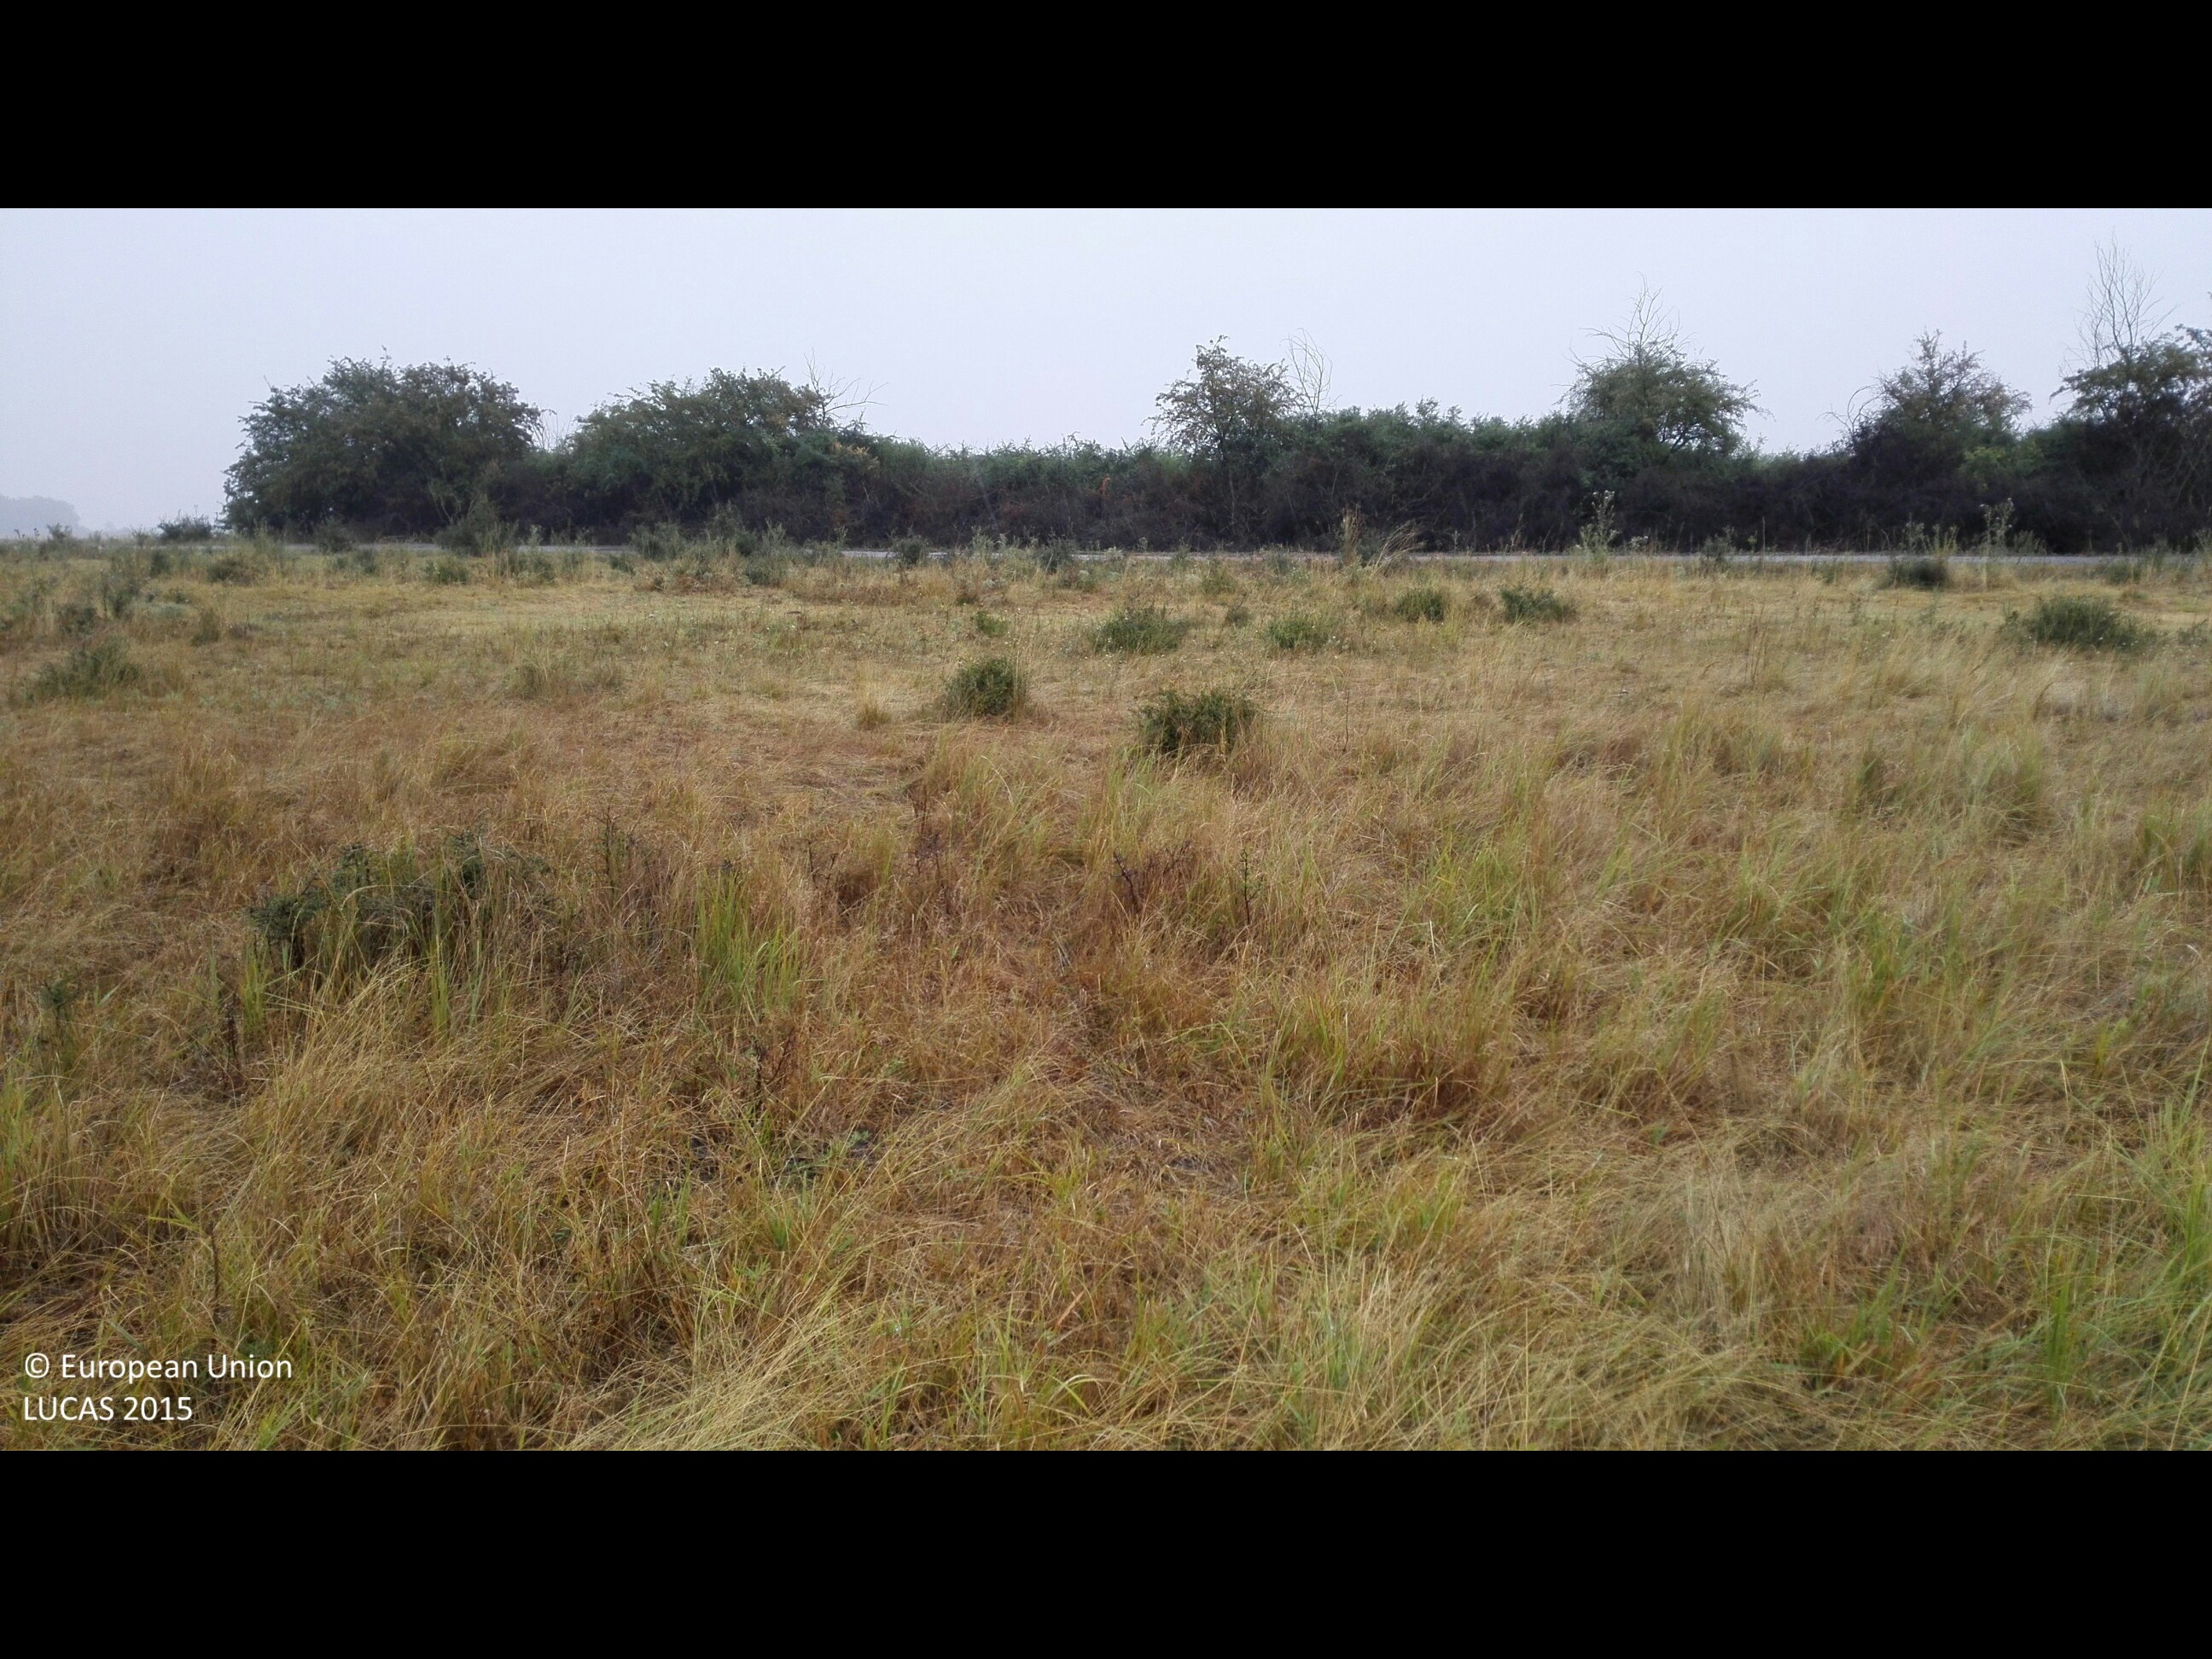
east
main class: Grassland
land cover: Grassland without tree/shrub cover
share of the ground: > 75 %
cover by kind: herbaceous plants 100 %
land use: Agriculture (excluding fallow land and kitchen gardens)
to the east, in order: Grassland without tree/shrub cover; Paved roads, cycling and walking lanes; Shrubland with sparse tree cover; Other bare soil; Abandoned hedges; Grassland without tree/shrub cover; Tracks; Grassland without tree/shrub cover
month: August
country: HU
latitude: 47.2697
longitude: 21.8765
